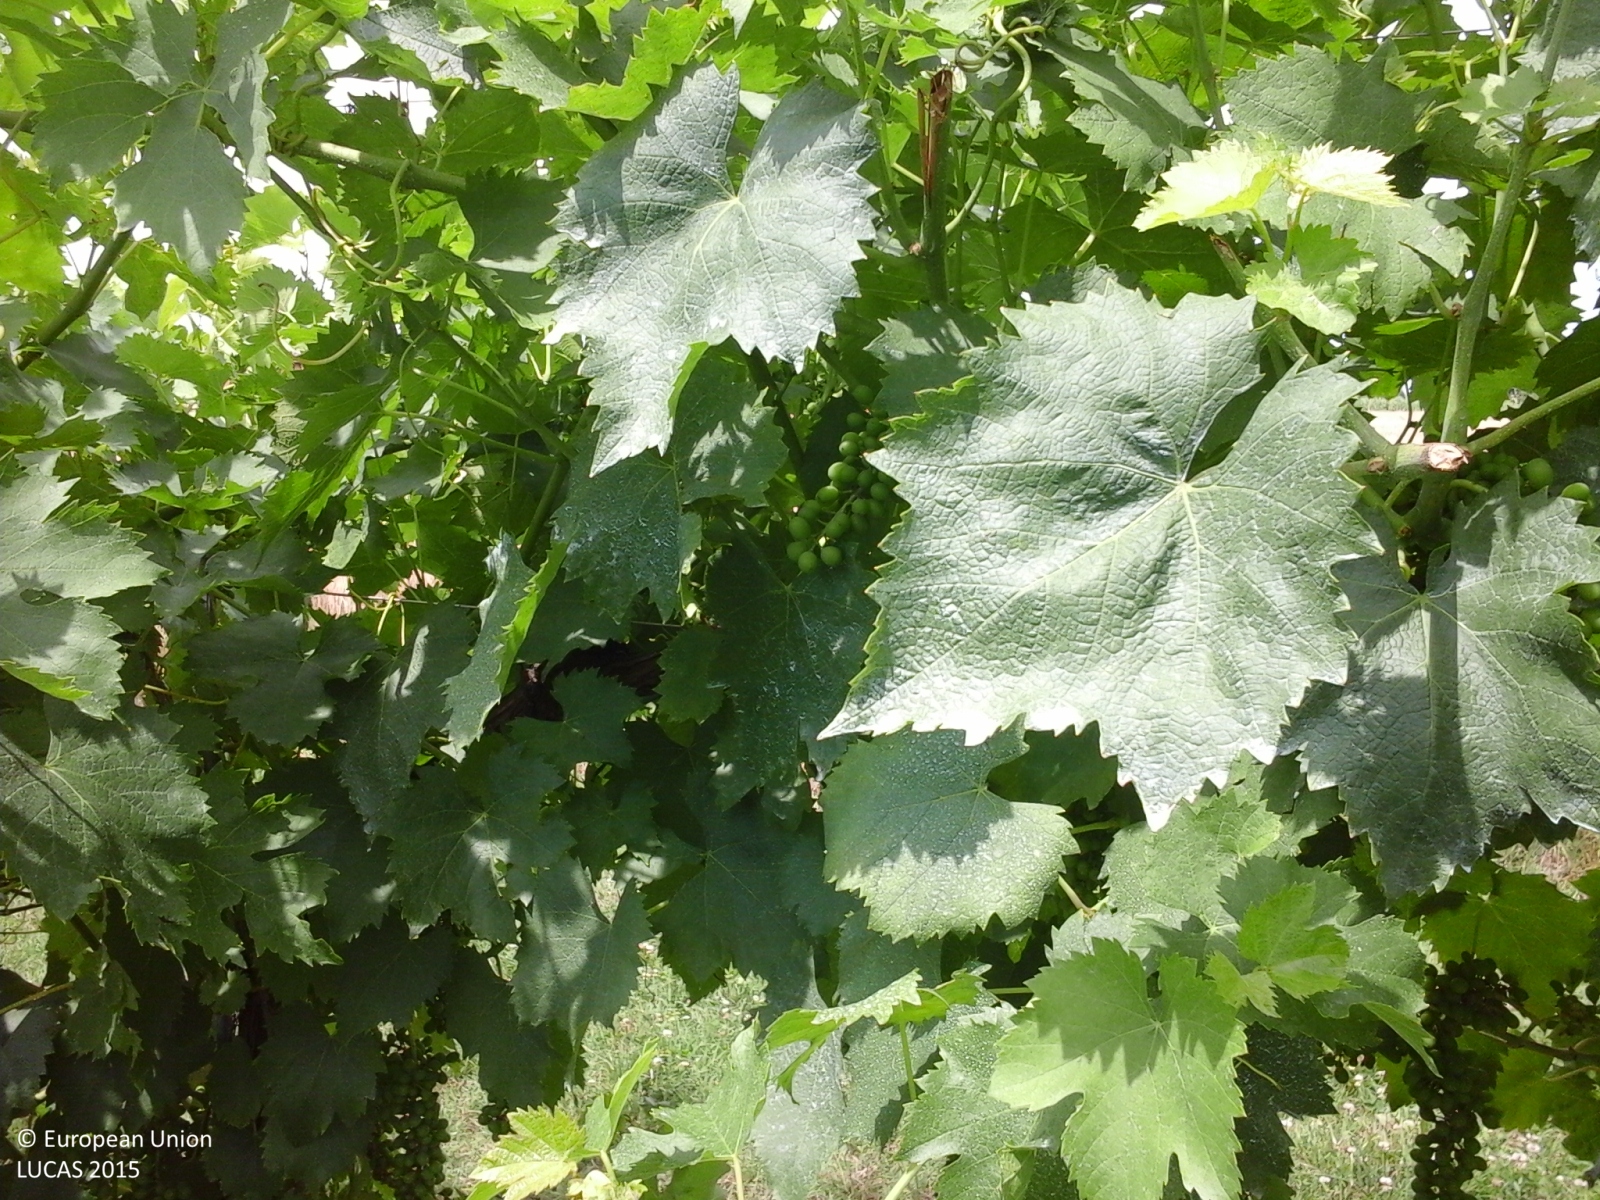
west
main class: Cropland
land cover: Vineyards
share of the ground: 50 - 75 %
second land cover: Grassland without tree/shrub cover
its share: > 75 %
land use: Agriculture (excluding fallow land and kitchen gardens)
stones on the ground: < 10 %
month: June
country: IT
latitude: 44.6519
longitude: 11.0444
